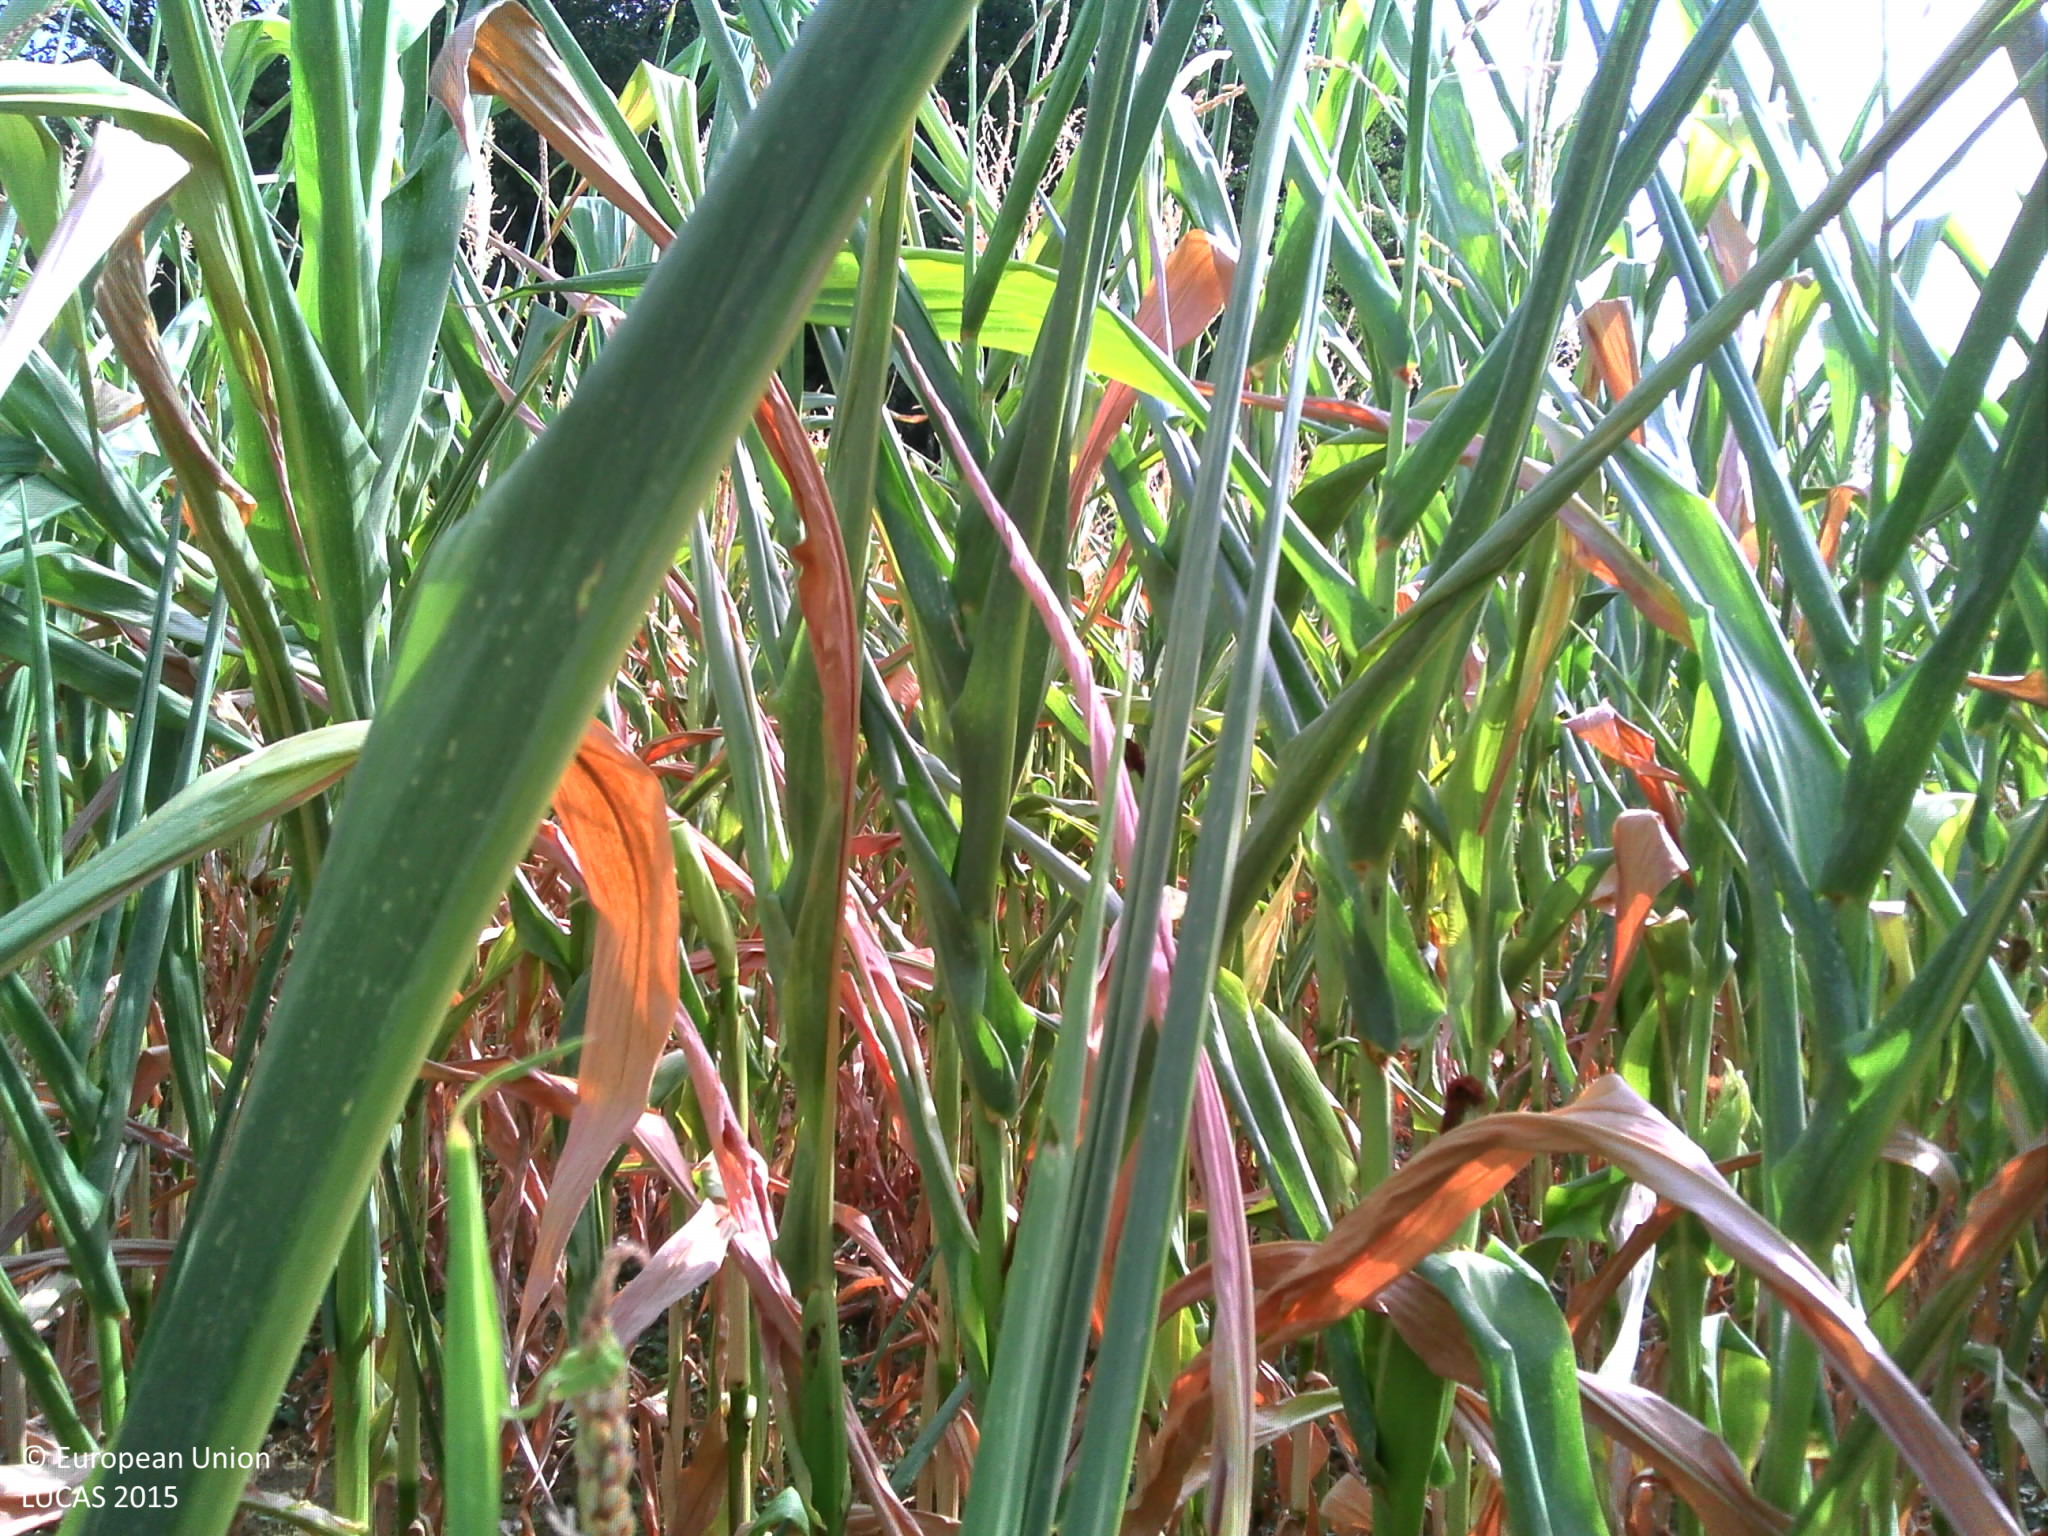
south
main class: Cropland
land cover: Maize
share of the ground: 50 - 75 %
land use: Agriculture (excluding fallow land and kitchen gardens)
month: August
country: FR
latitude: 44.5593
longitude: 0.6133
